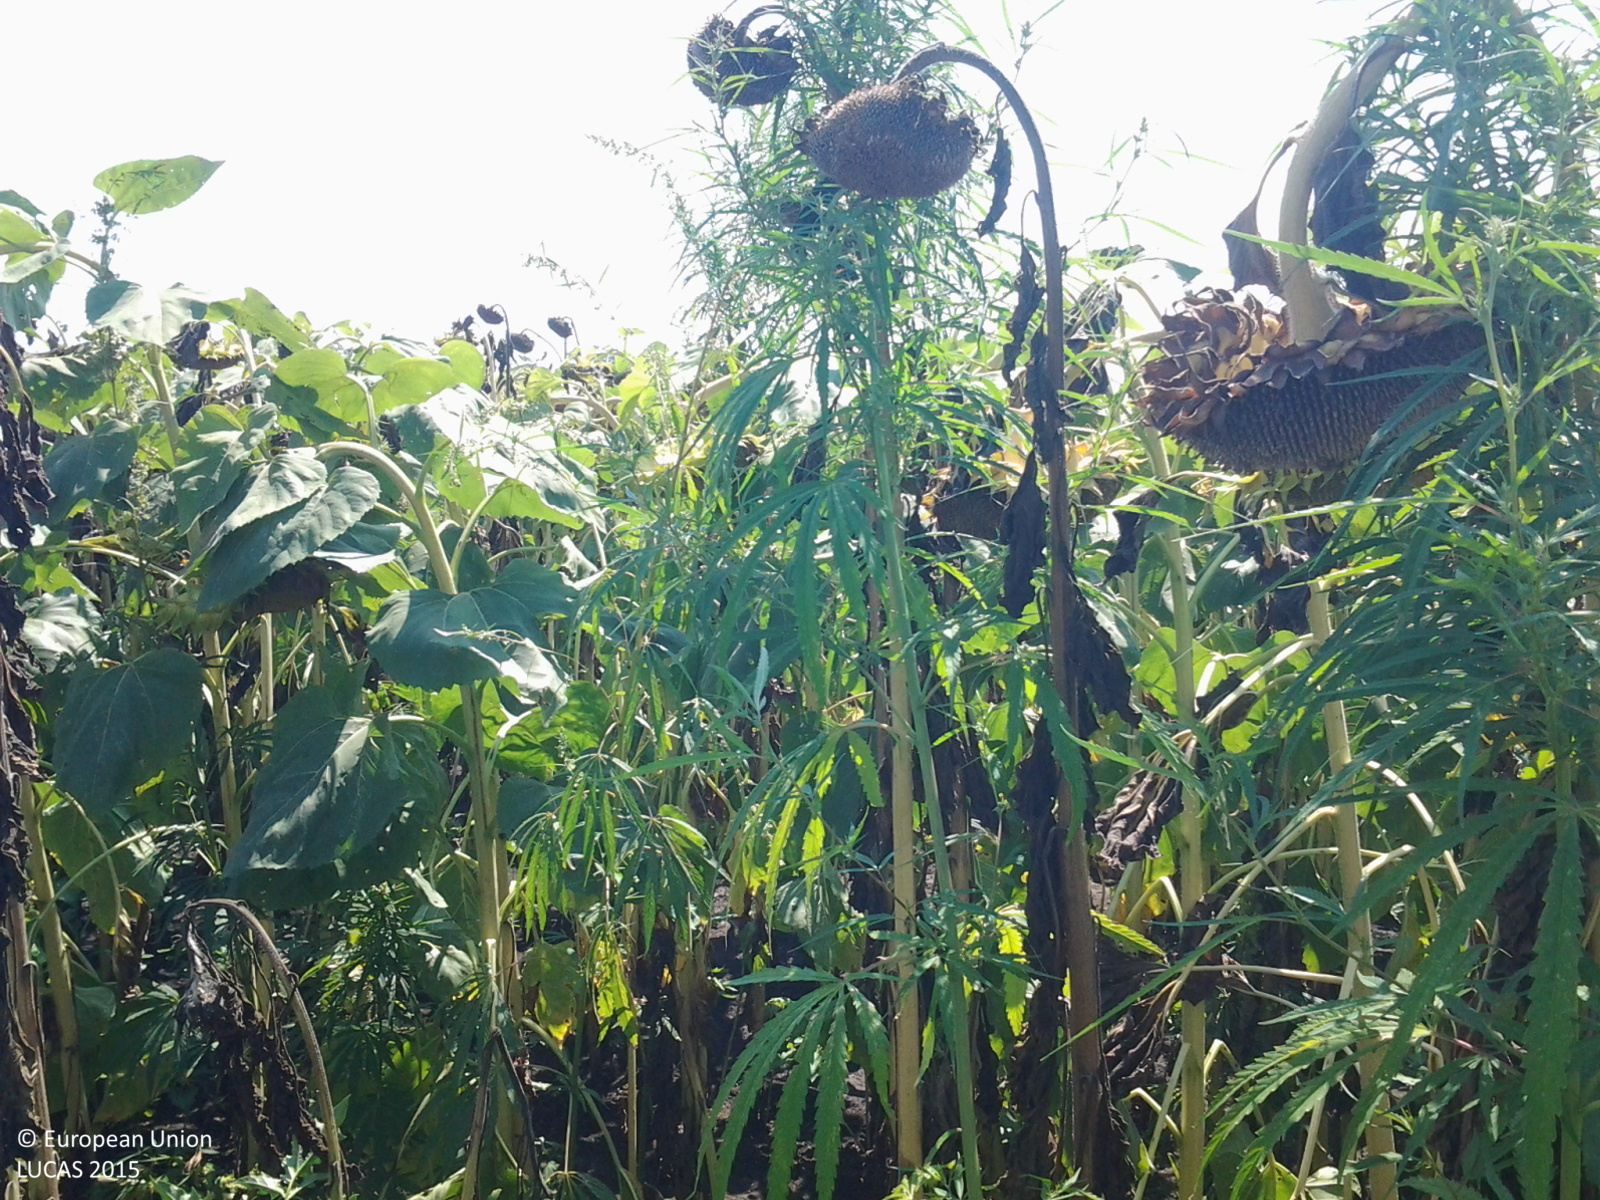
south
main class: Cropland
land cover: Sunflower
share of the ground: > 75 %
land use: Agriculture (excluding fallow land and kitchen gardens)
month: August
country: HU
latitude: 47.2386
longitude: 19.8384
